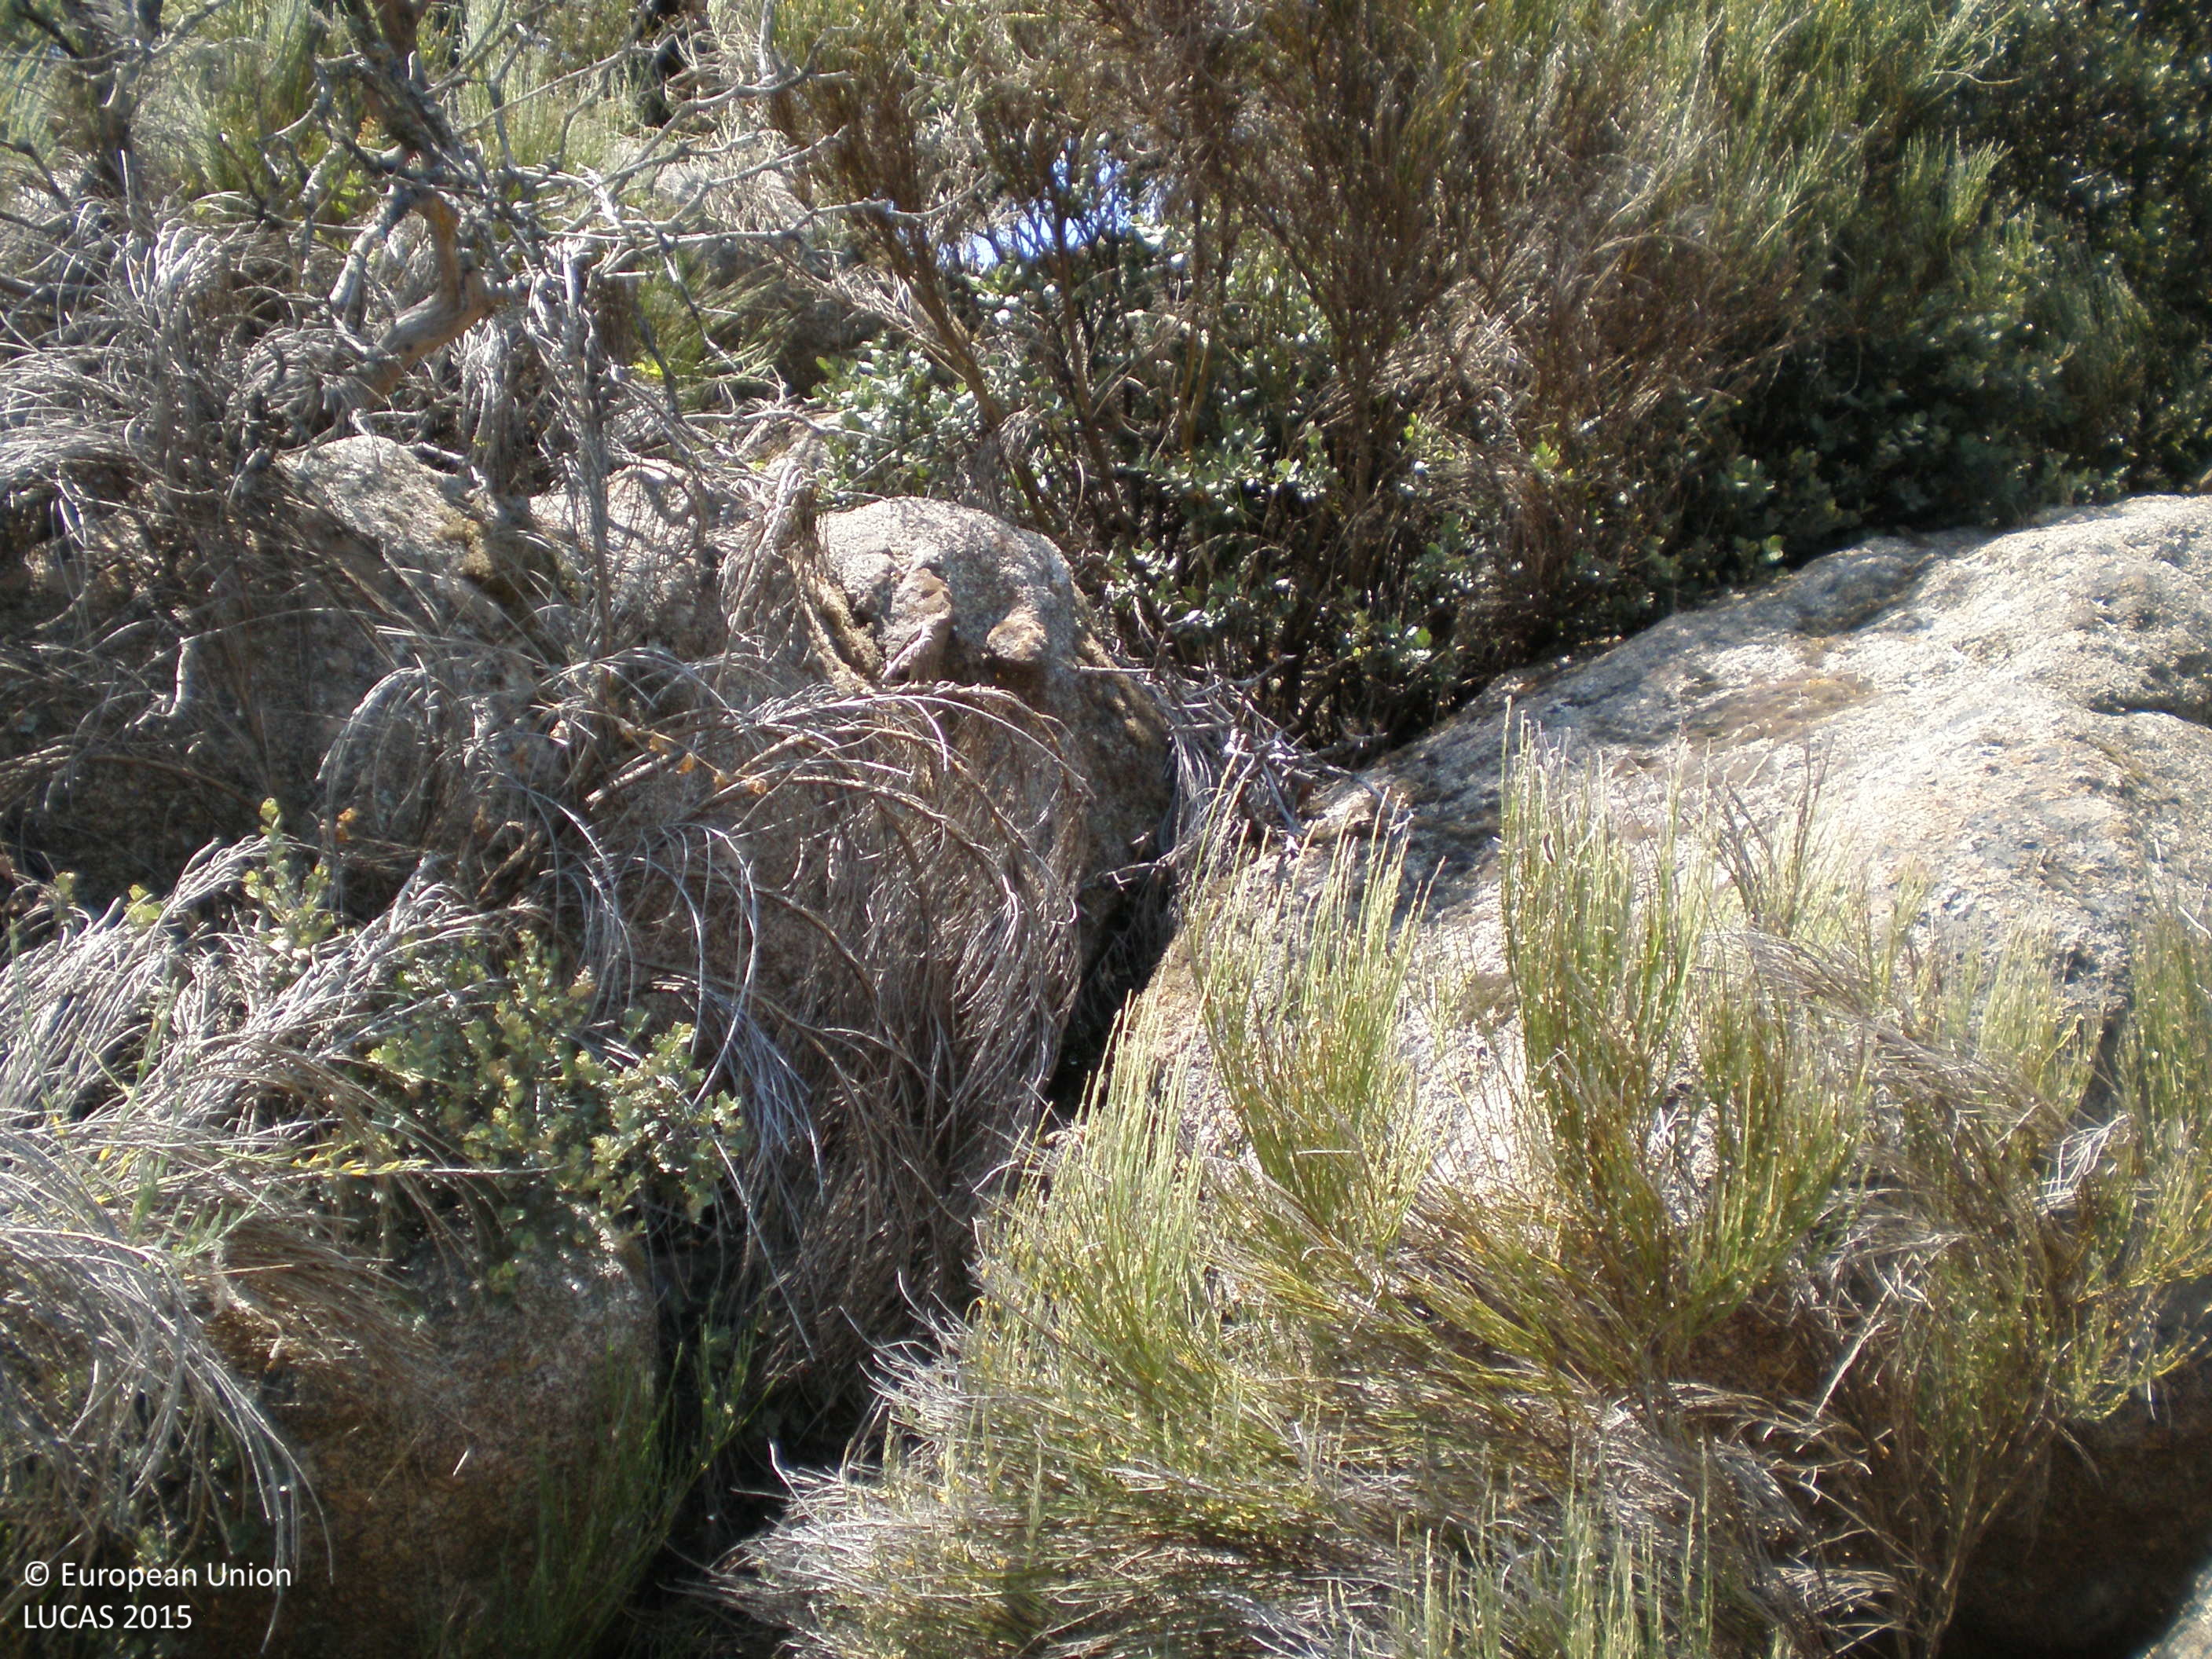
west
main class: Shrubland
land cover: Shrubland with sparse tree cover
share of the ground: 50 - 75 %
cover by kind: shrubs 60 %, herbaceous plants 20 %, consolidated bare surface 15 %, broadleaved forest trees 5 %
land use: Agriculture (excluding fallow land and kitchen gardens)
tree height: < 5 m
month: July
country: ES
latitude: 40.4277
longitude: -5.5916
